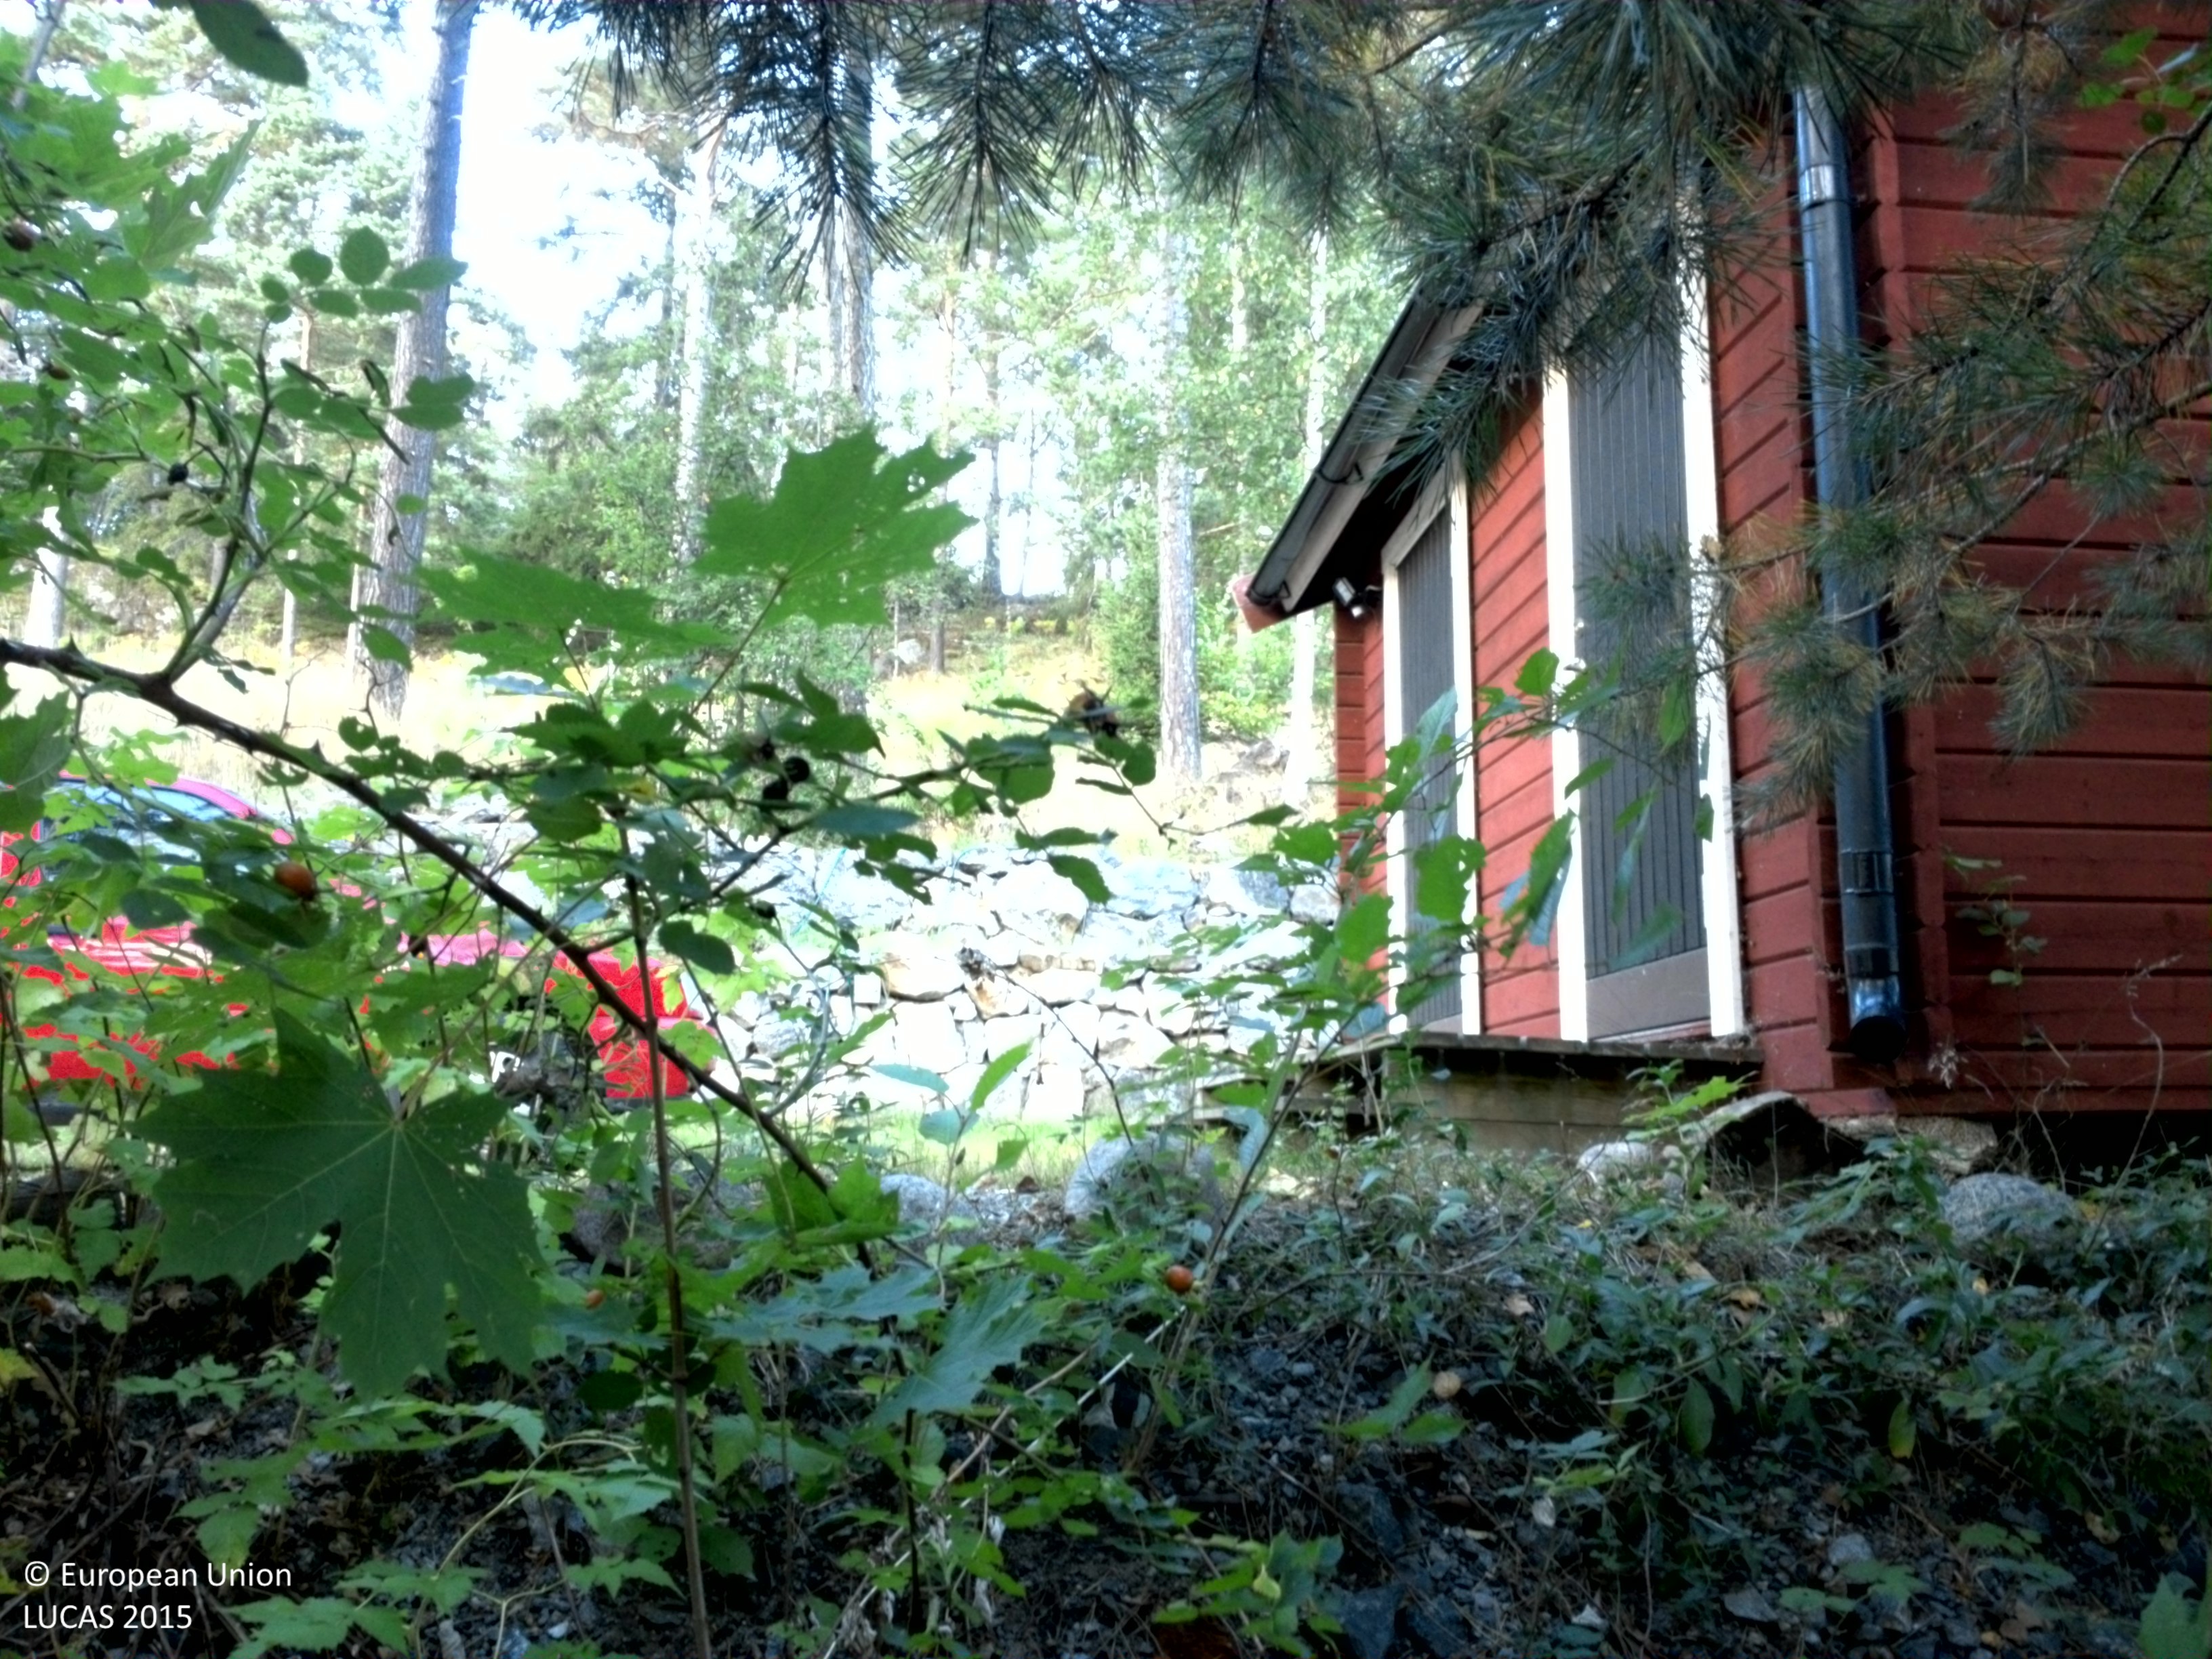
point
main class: Woodland
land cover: Broadleaved woodland
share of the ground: 50 - 75 %
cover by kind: broadleaved forest trees 60 %, herbaceous plants 40 %
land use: Semi-natural and natural areas not in use
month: September
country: SE
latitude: 59.2868
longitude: 18.5501
